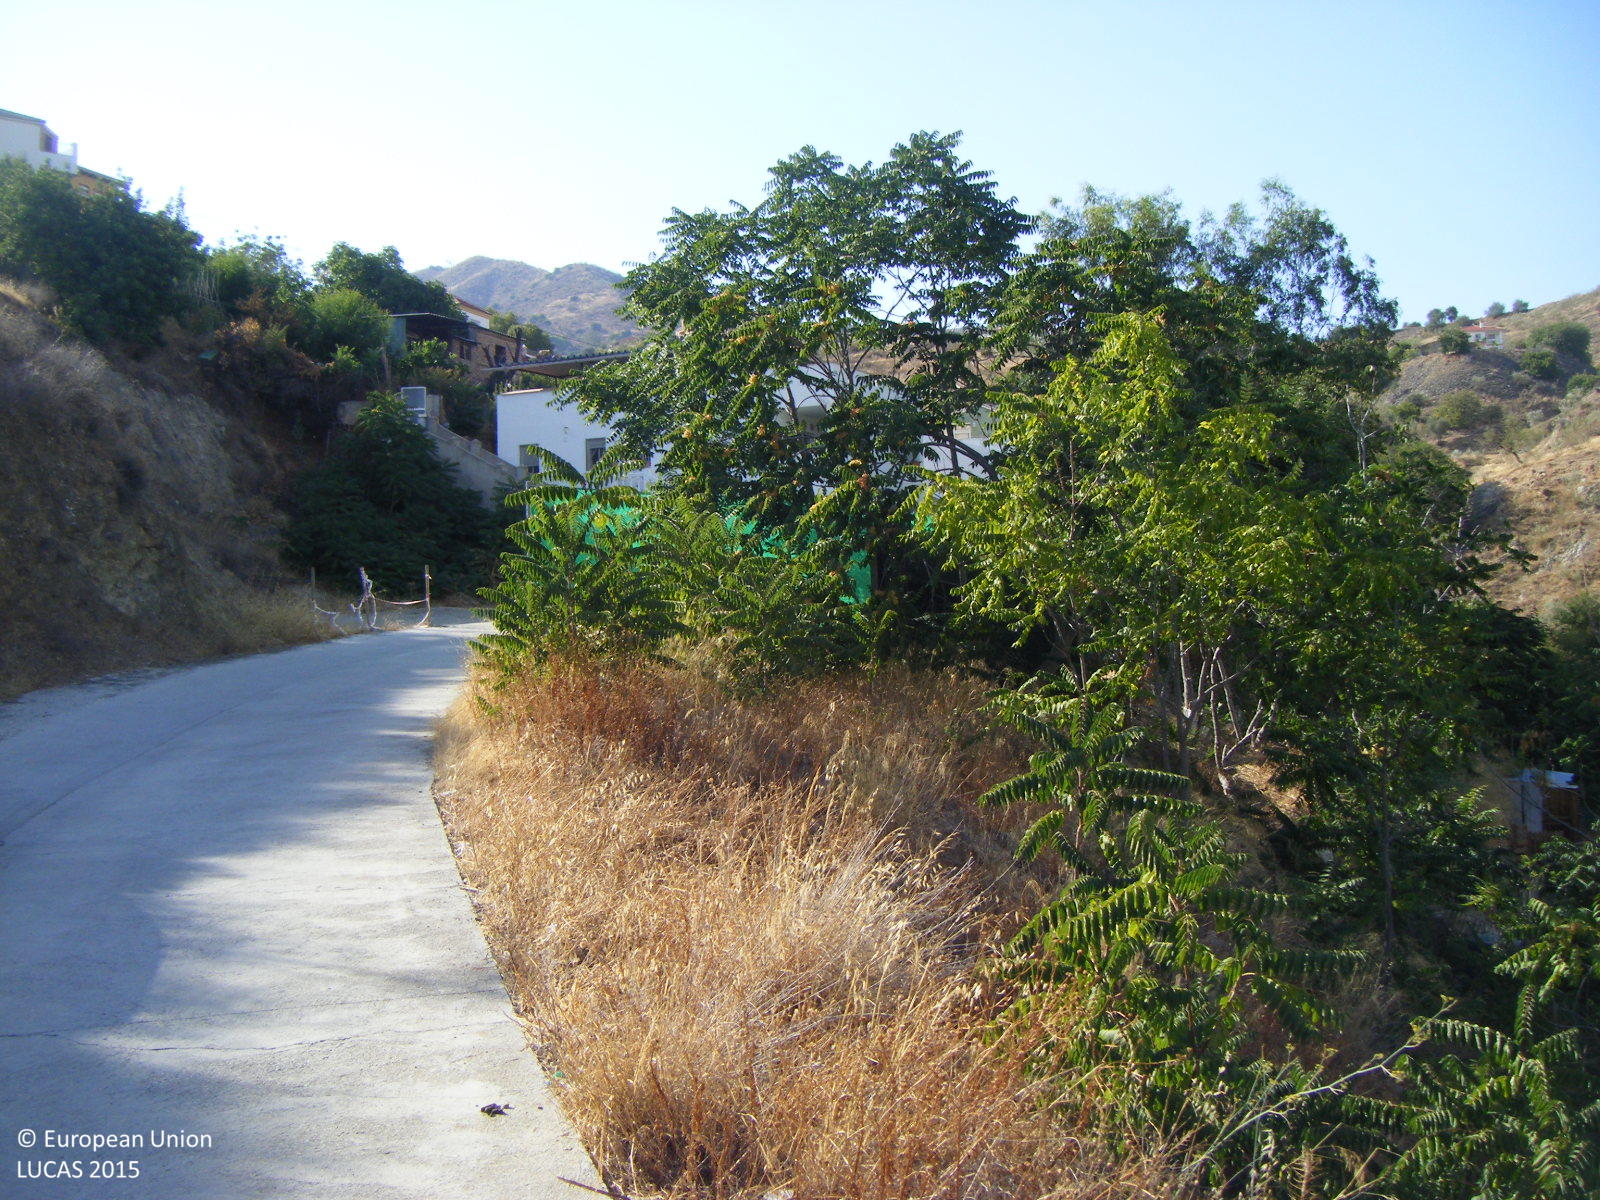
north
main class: Cropland
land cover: Nuts trees
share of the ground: 10 - 25 %
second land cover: Other bare soil
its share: > 75 %
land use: Agriculture (excluding fallow land and kitchen gardens)
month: July
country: ES
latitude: 36.7870
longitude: -4.4355
